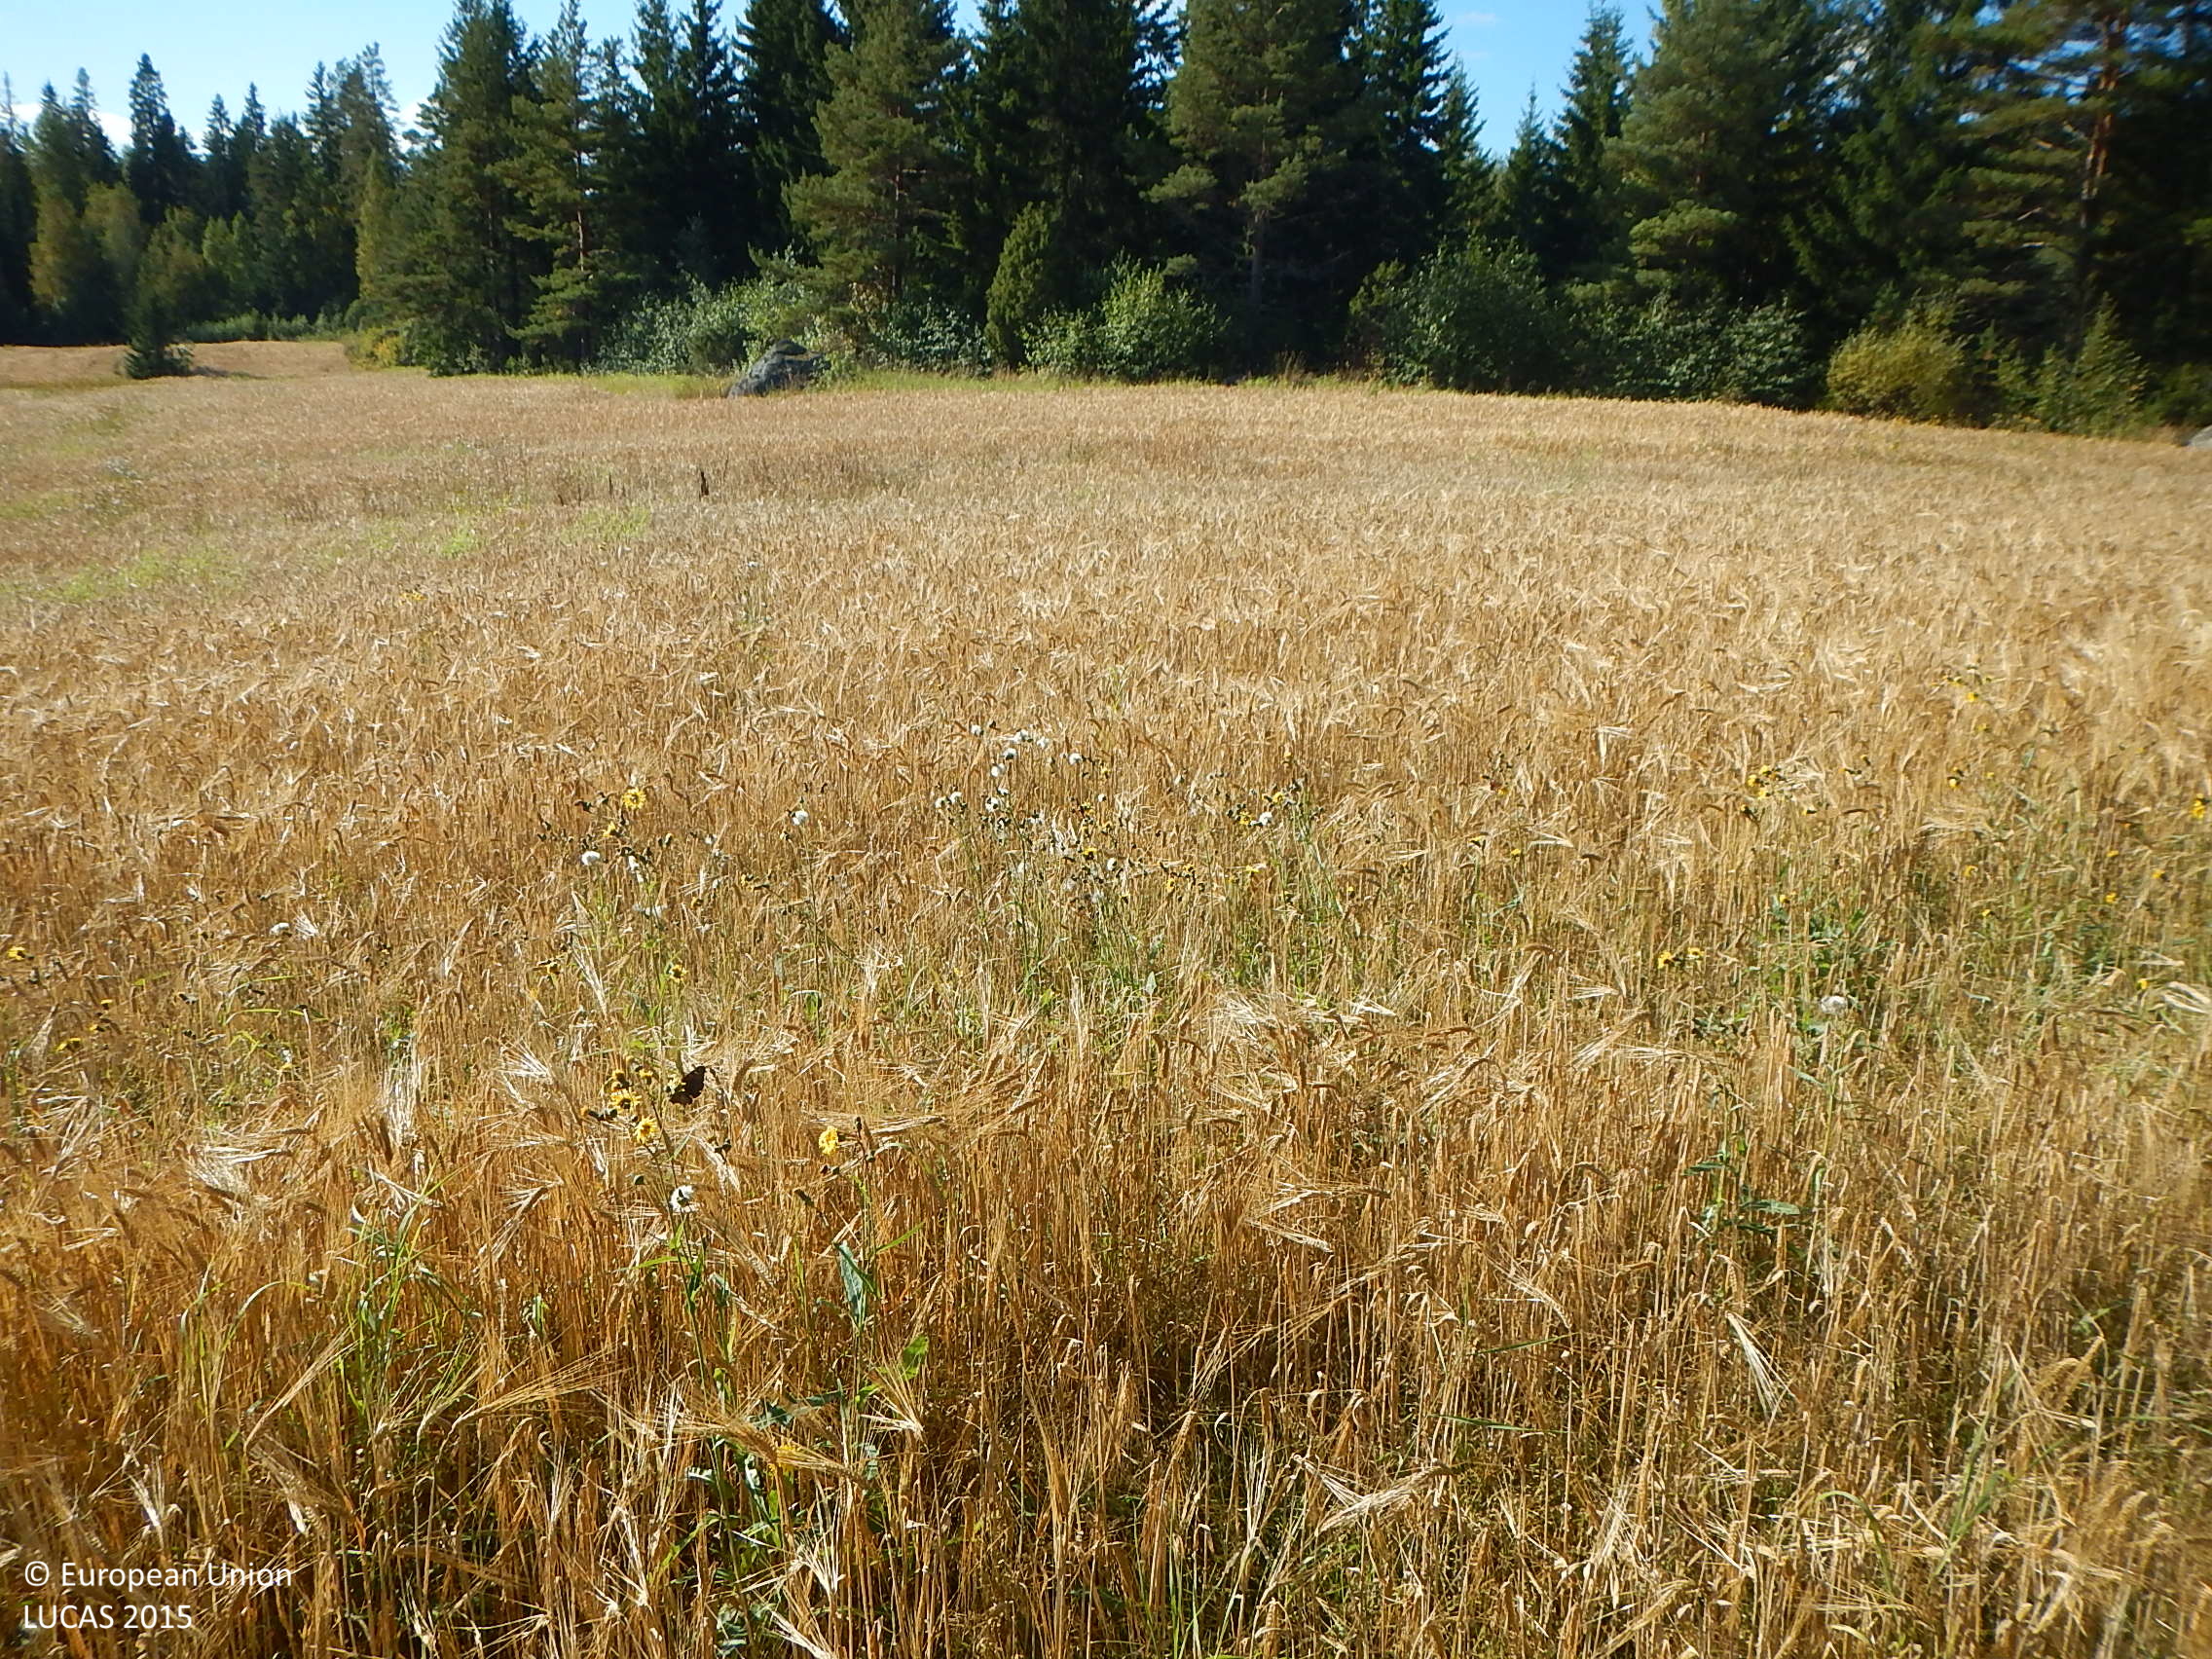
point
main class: Cropland
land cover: Barley
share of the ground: > 75 %
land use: Agriculture (excluding fallow land and kitchen gardens)
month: September
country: FI
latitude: 61.5921
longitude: 22.7473
